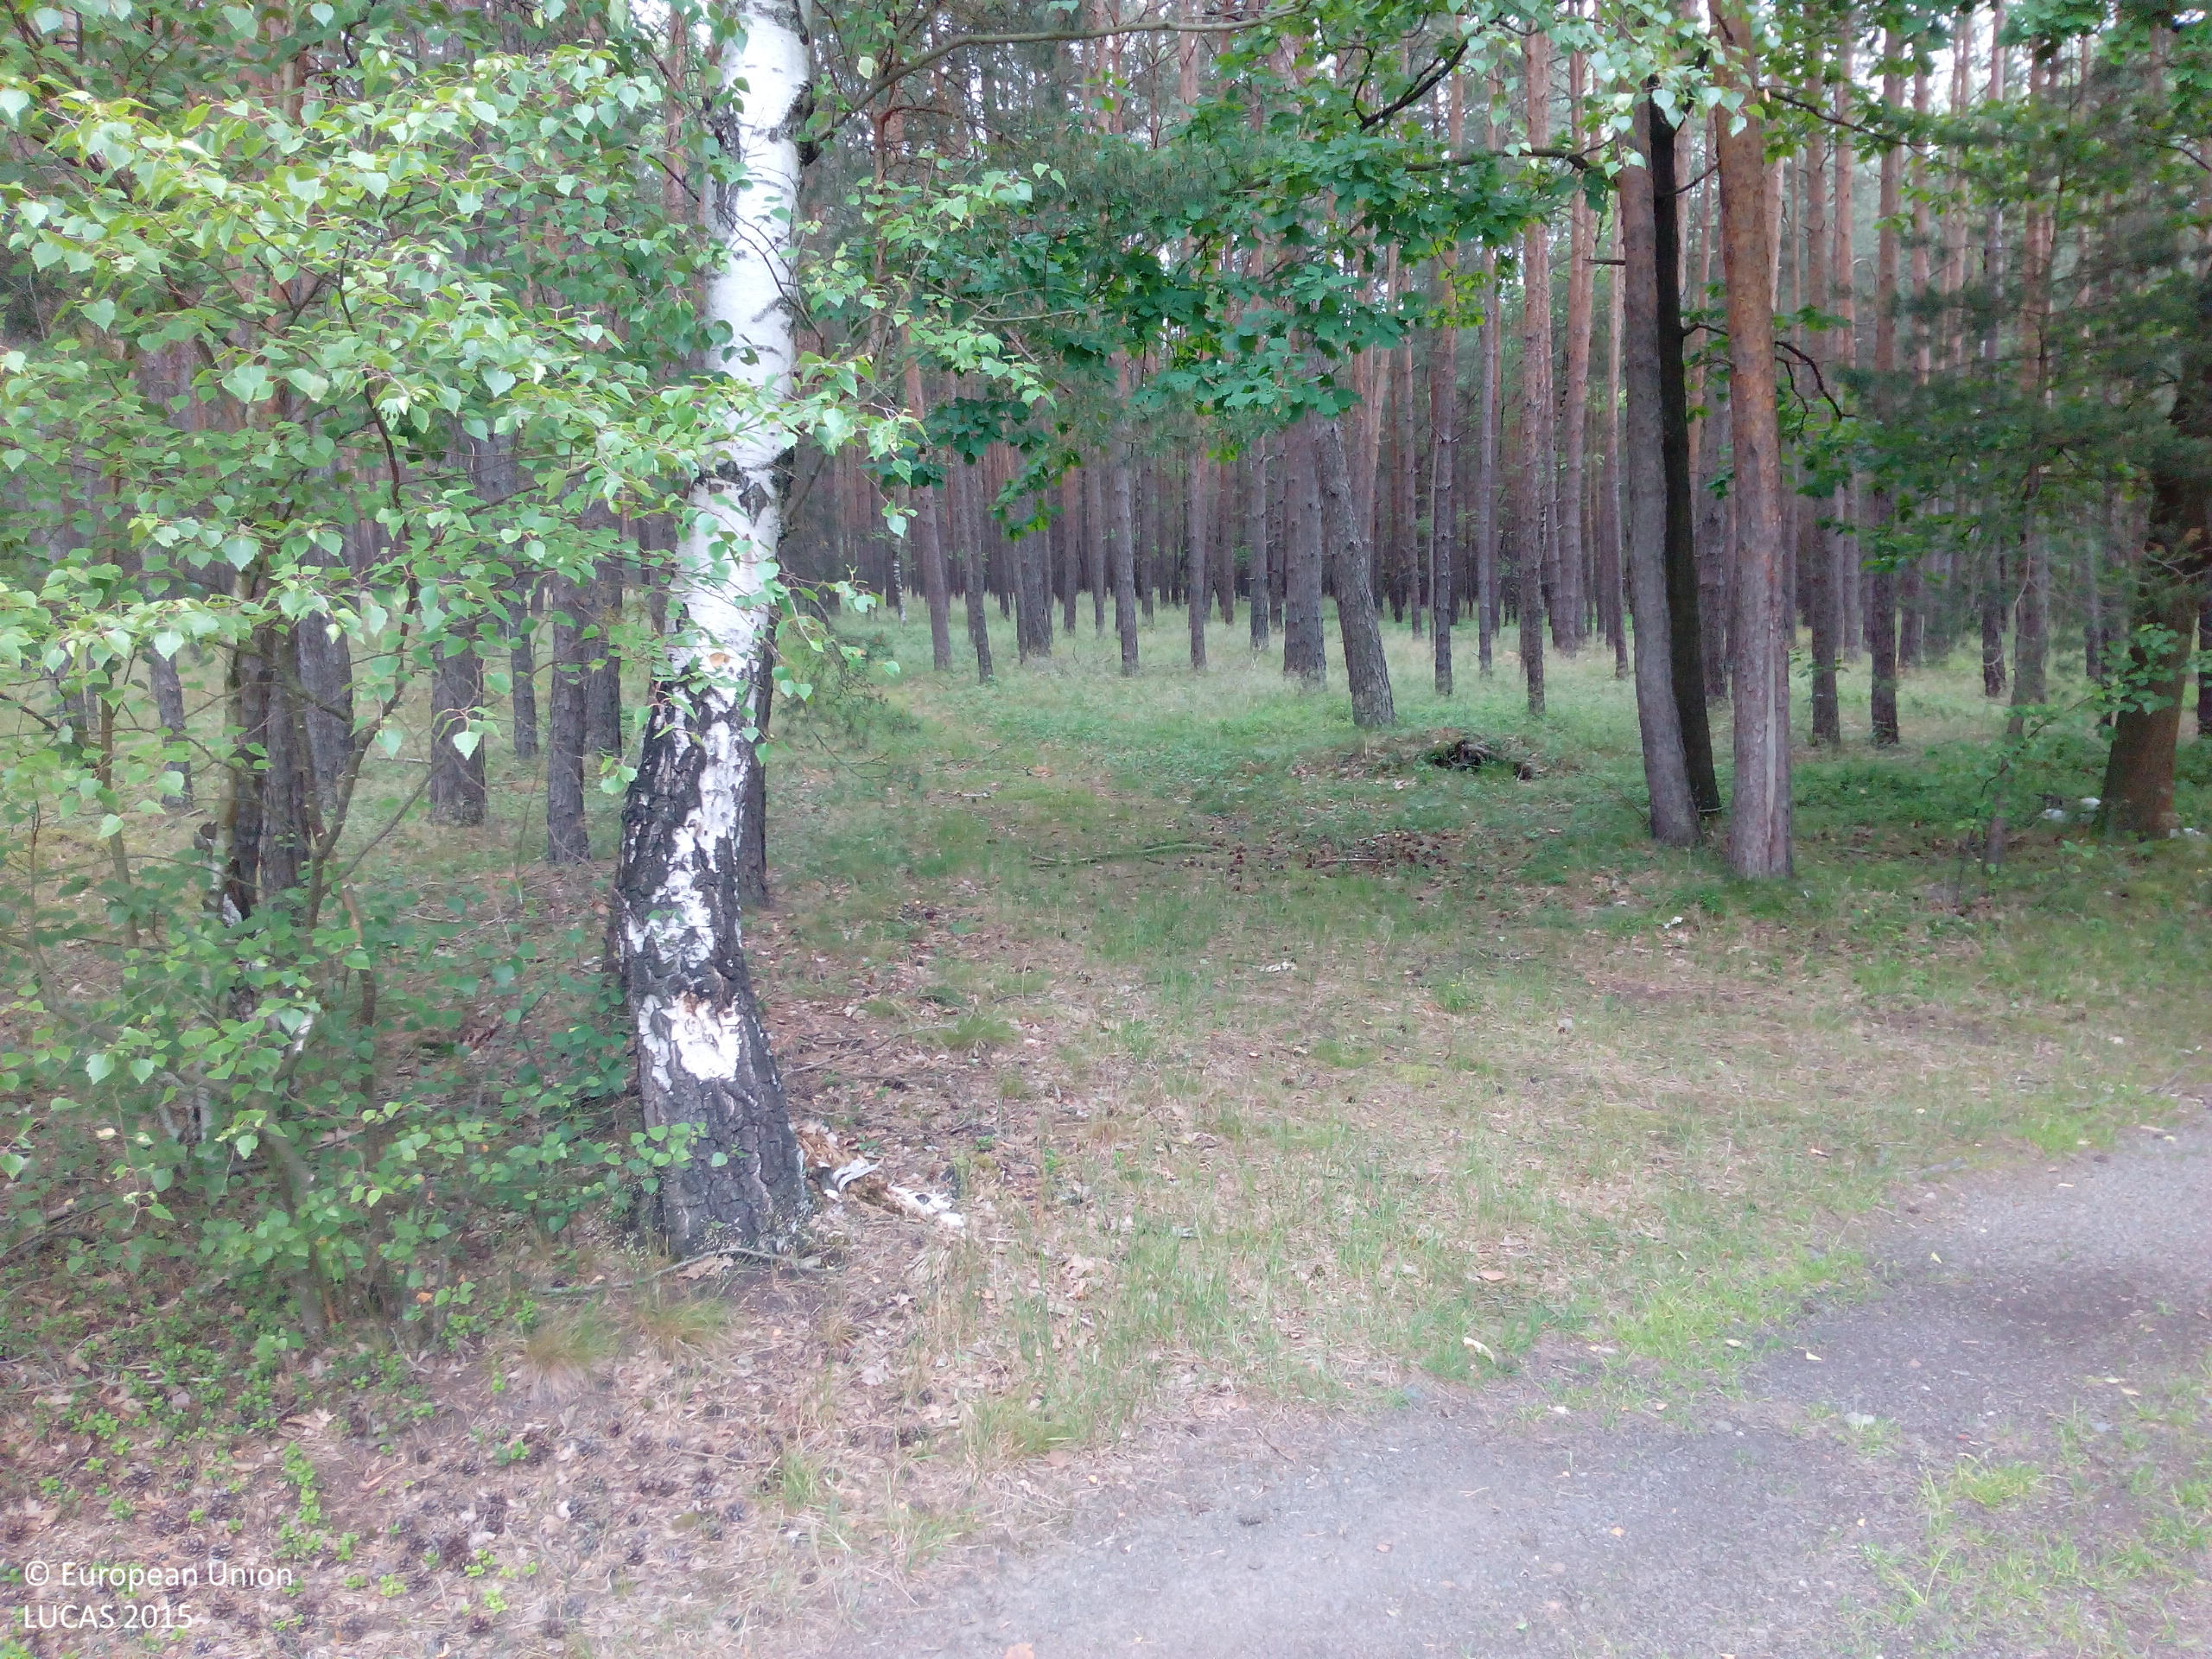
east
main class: Woodland
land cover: Pine dominated mixed woodland
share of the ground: > 75 %
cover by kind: coniferous forest trees 65 %, broadleaved forest trees 25 %, herbaceous plants 10 %
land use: Forestry
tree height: > 5 m
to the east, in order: Grass margins; Tracks; Pine dominated mixed woodland; Pine dominated coniferous woodland; Tracks; Pine dominated coniferous woodland
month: June
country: DE
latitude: 51.3560
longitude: 14.0075
